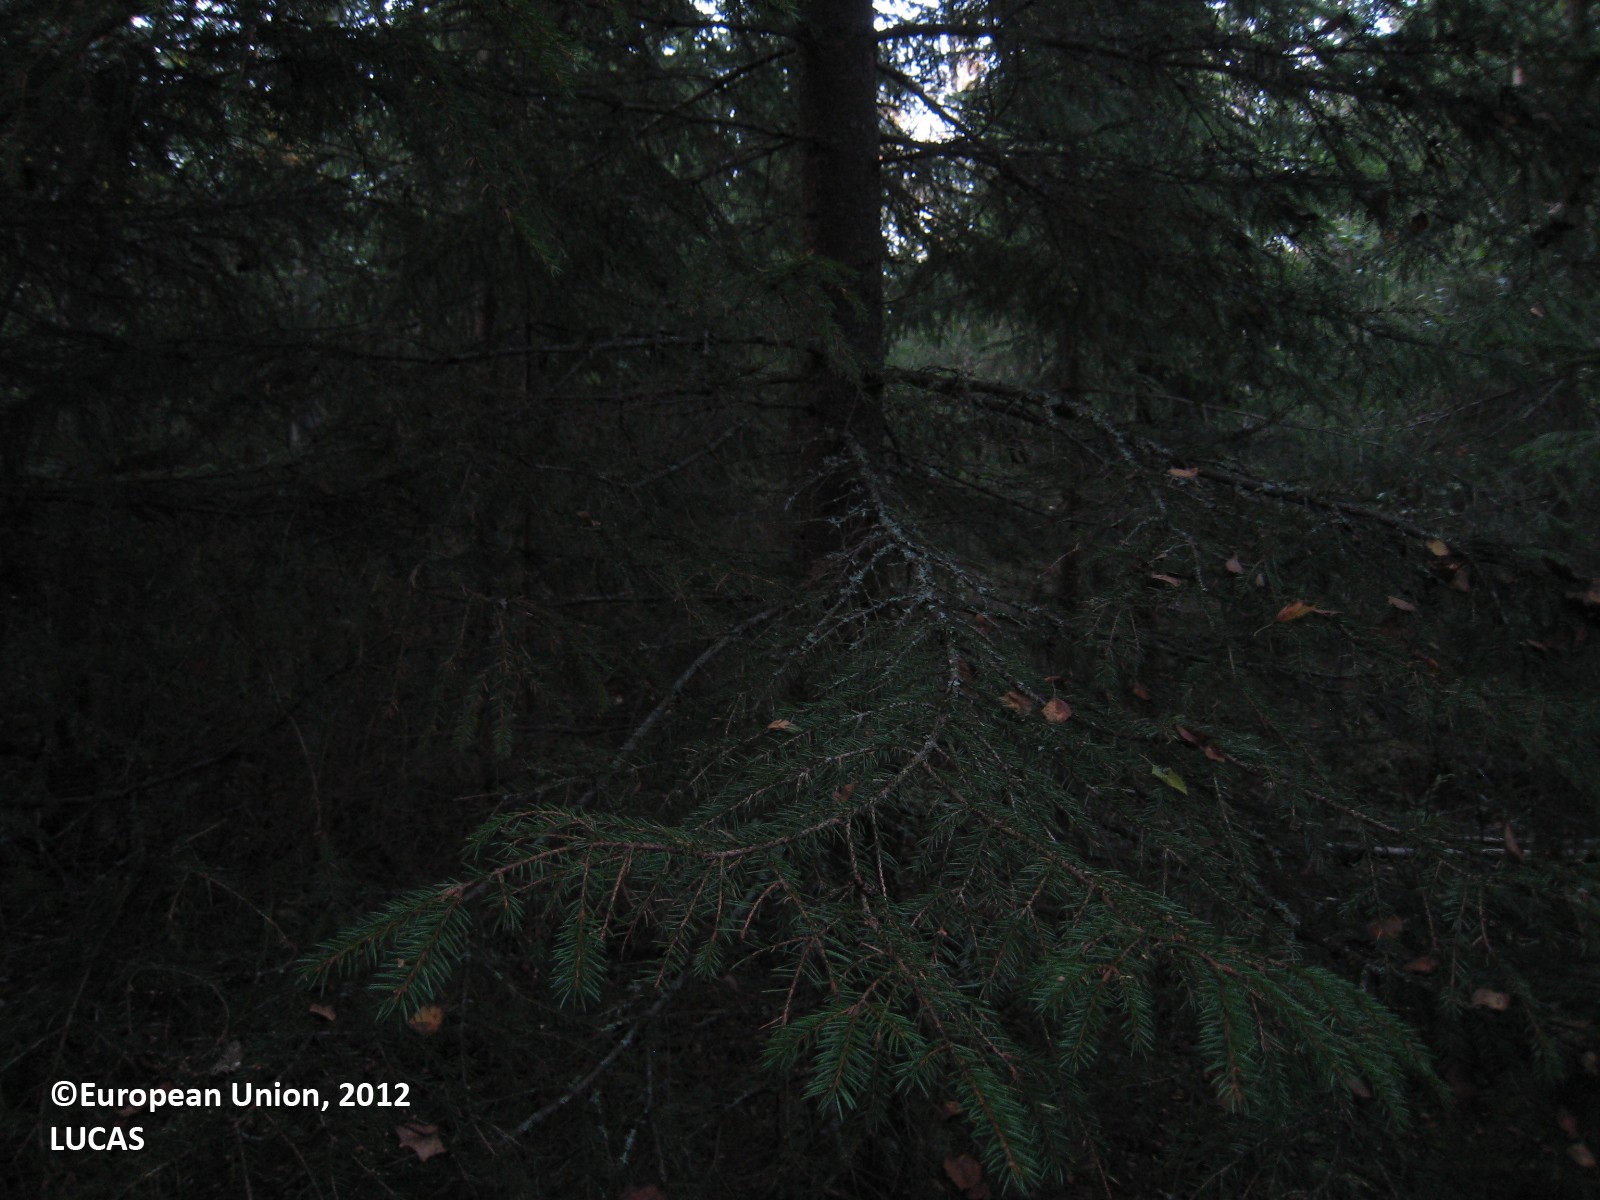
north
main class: Woodland
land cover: Spruce dominated mixed woodland
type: boreal forest
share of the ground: > 75 %
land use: Forestry
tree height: > 5 m
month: September
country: FI
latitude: 62.7972
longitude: 26.5475
